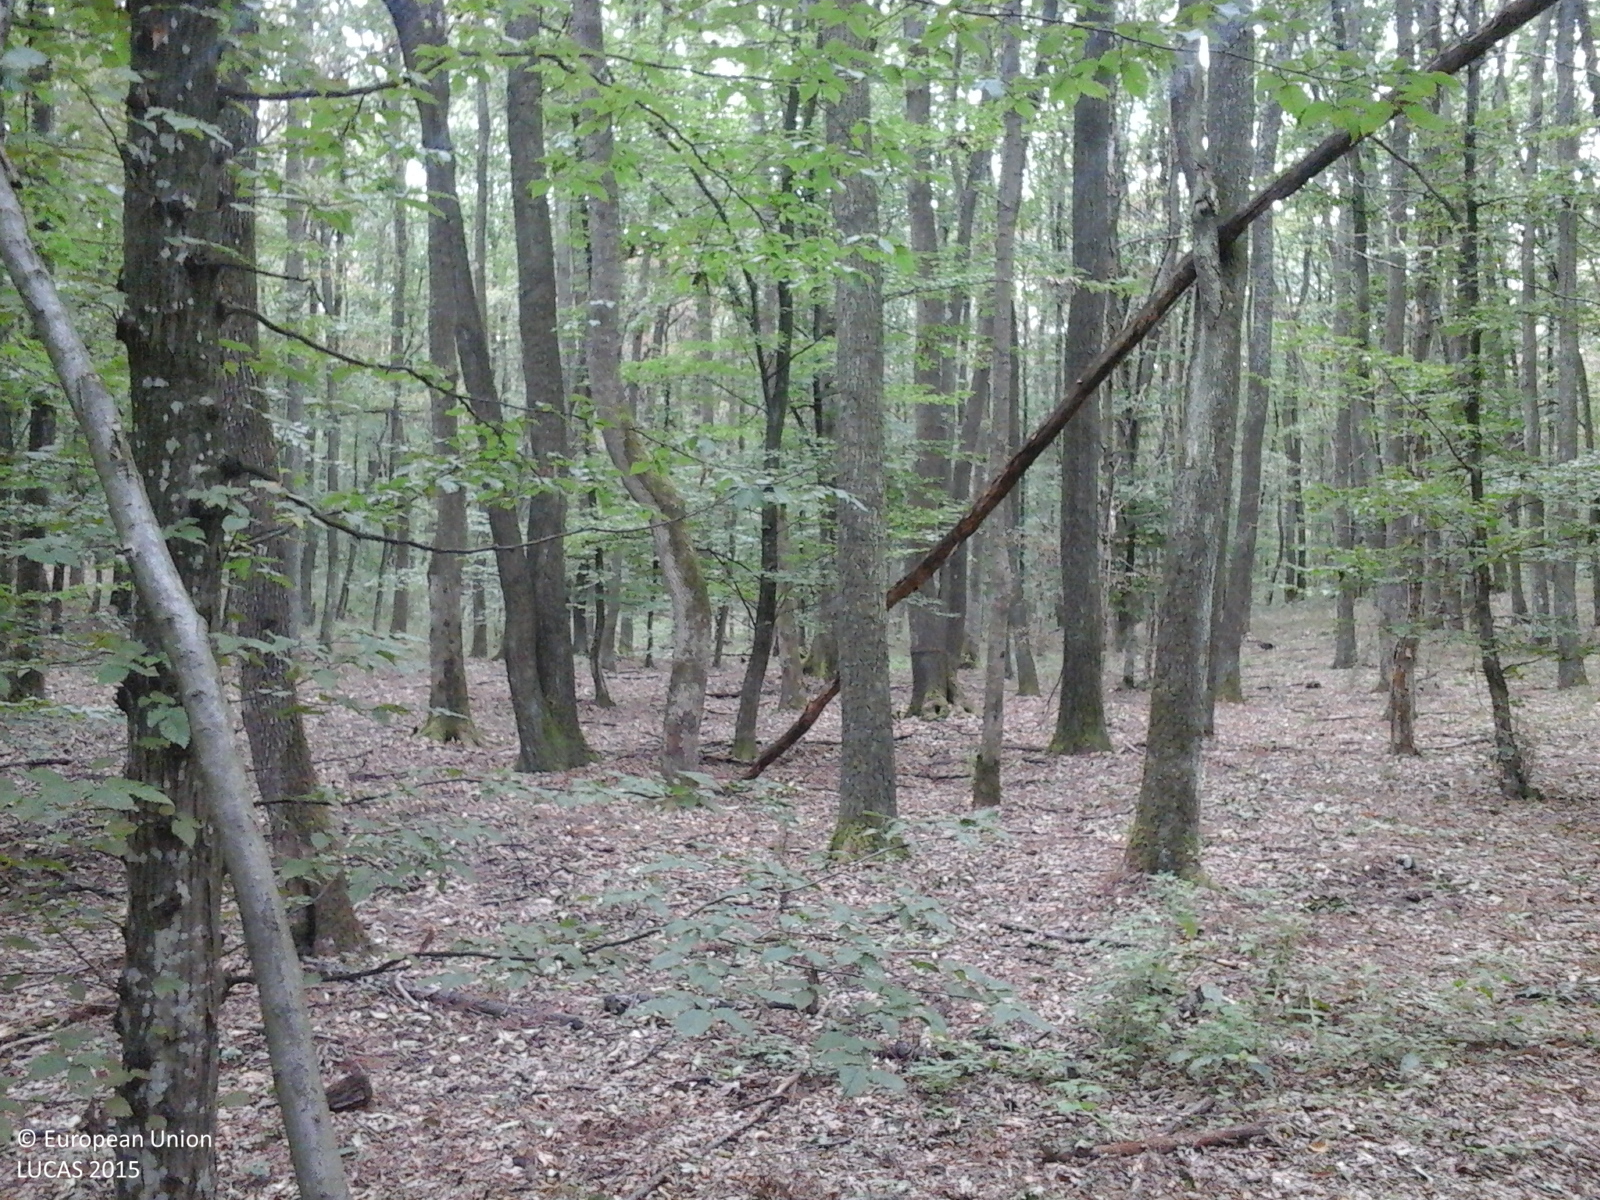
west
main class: Woodland
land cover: Broadleaved woodland
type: acidophilous oak and oak-birch forest
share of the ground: > 75 %
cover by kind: broadleaved forest trees 100 %
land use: Forestry
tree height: > 5 m
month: September
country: RO
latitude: 47.3991
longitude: 22.6596
